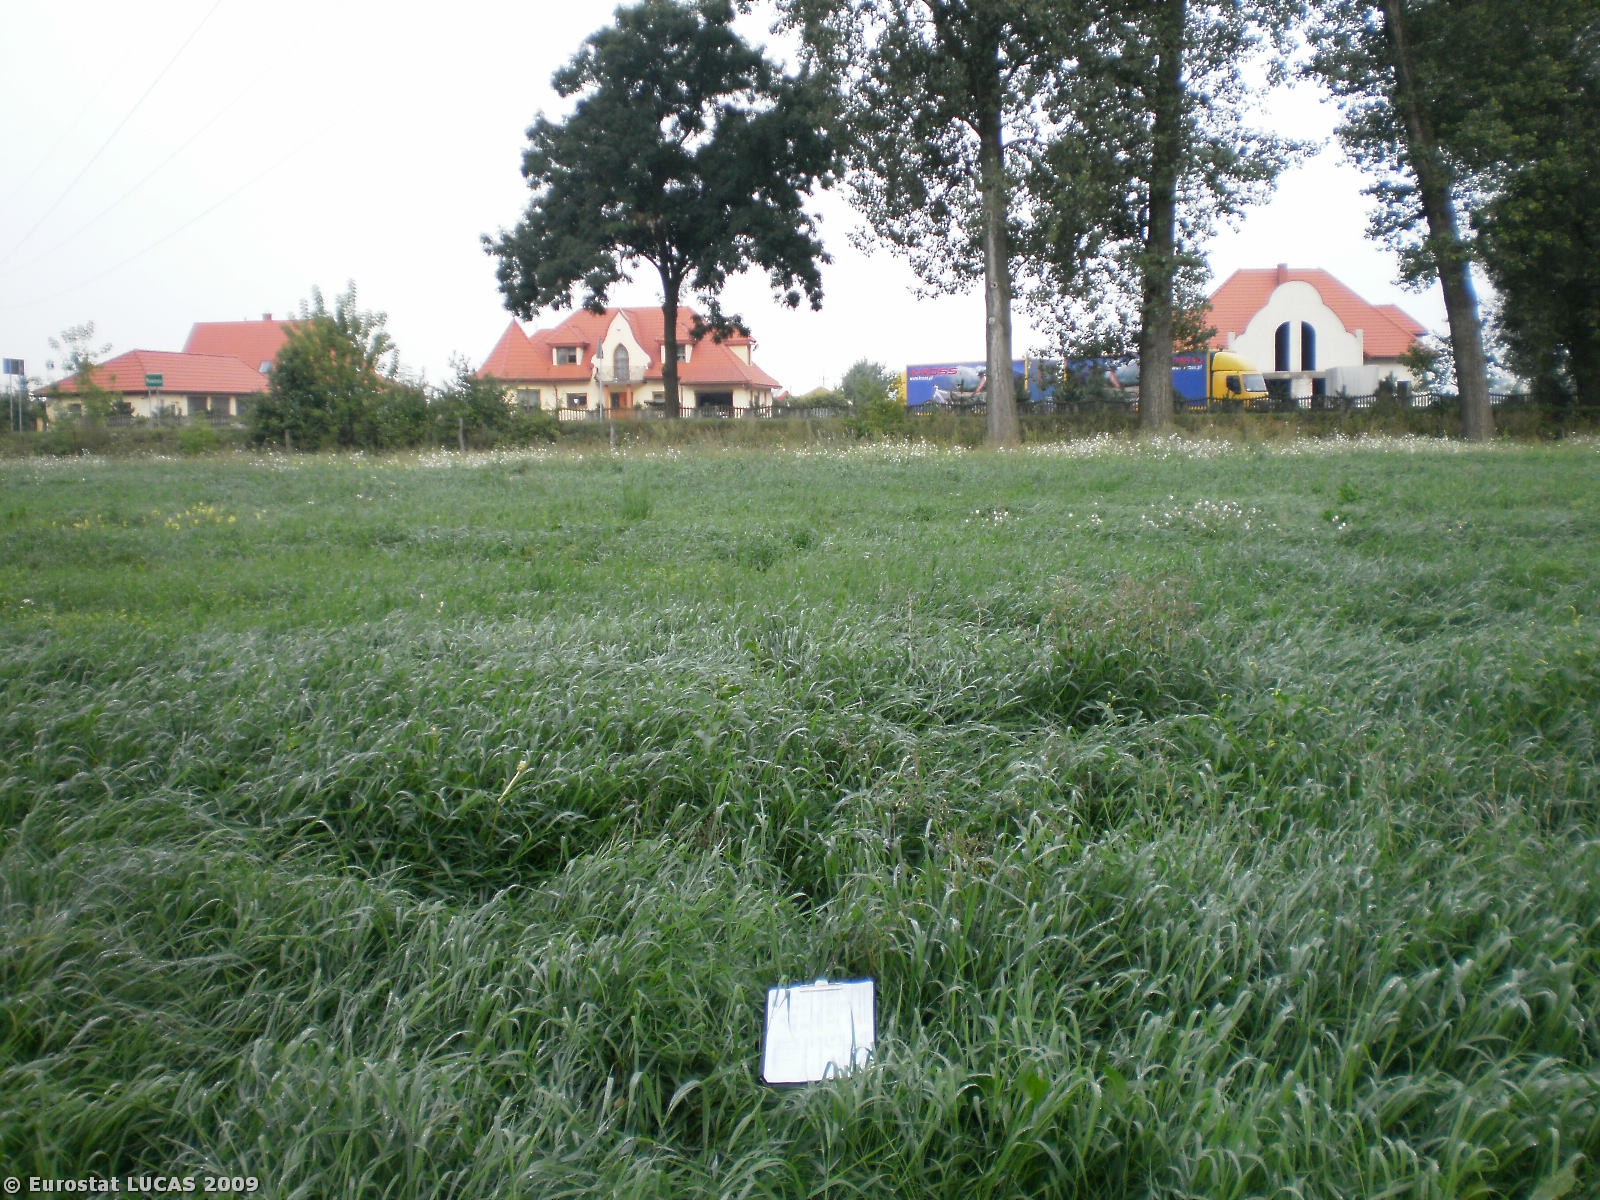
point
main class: Grassland
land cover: Grassland without tree/shrub cover
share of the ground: > 75 %
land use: Agriculture (excluding fallow land and kitchen gardens)
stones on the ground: < 10 %
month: August
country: PL
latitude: 53.0341
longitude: 20.9138
